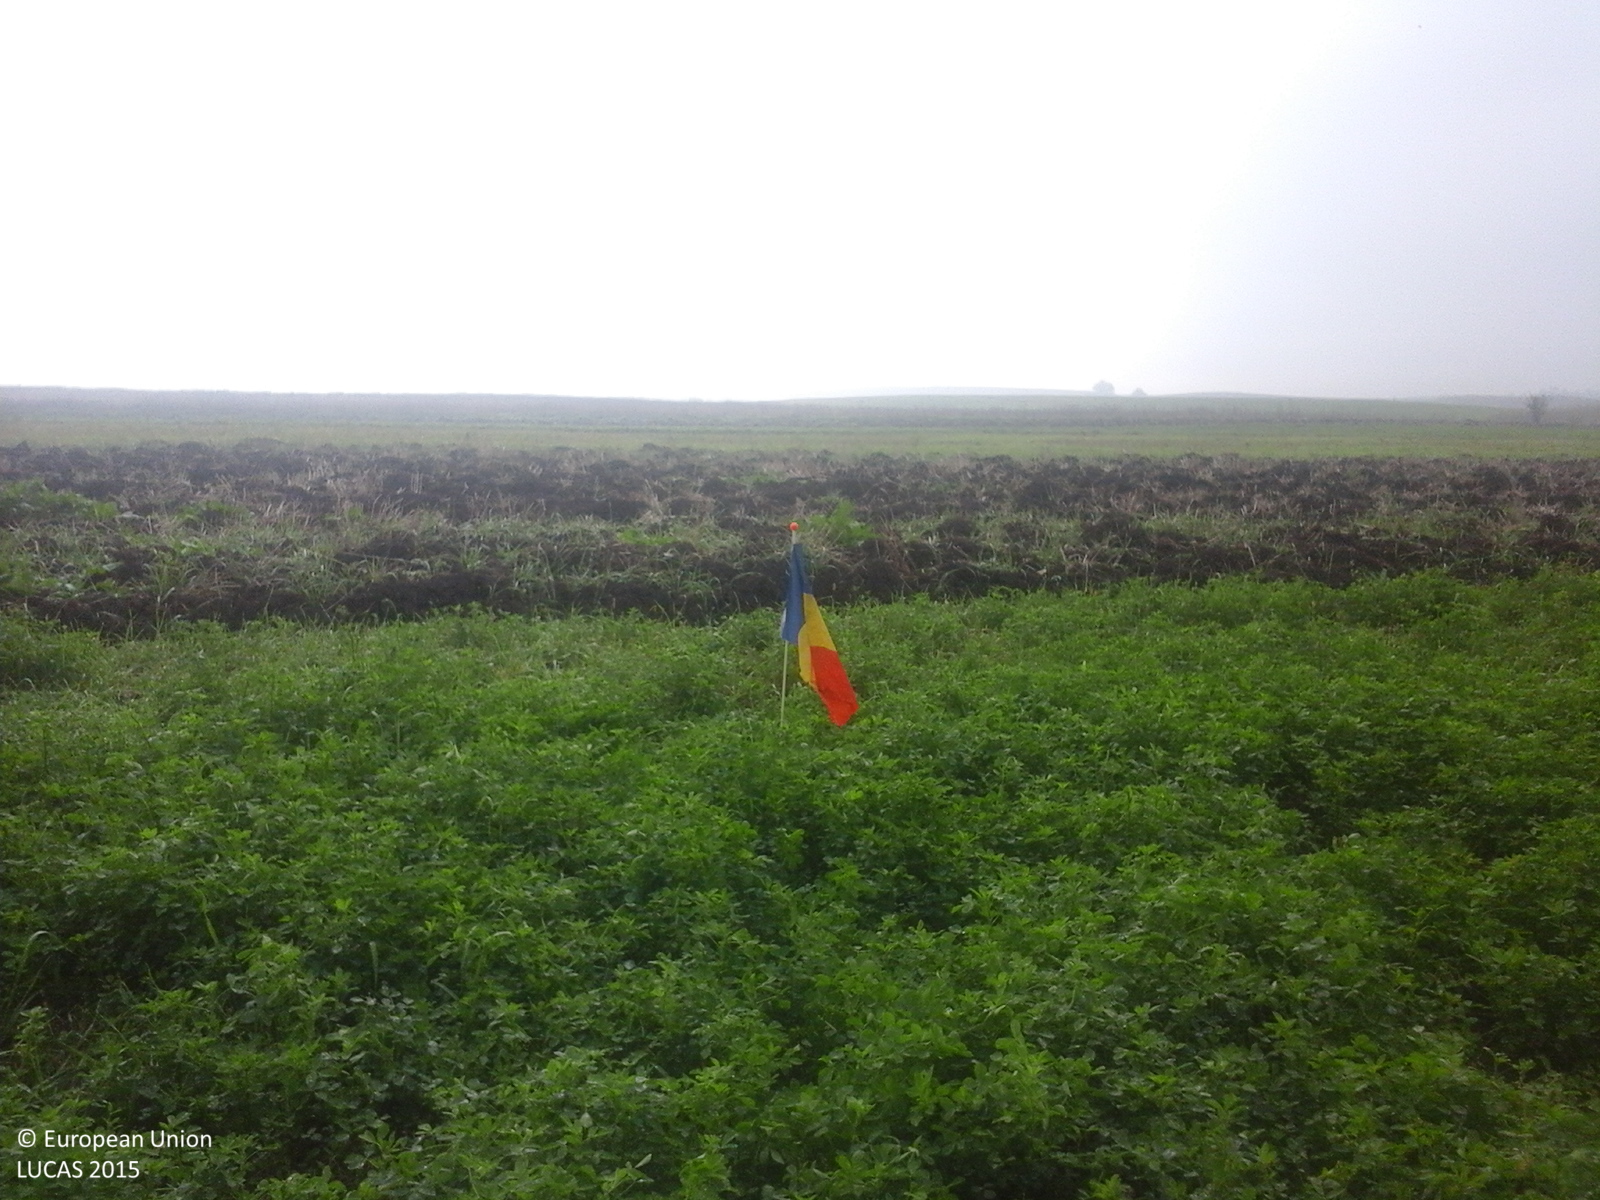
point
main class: Cropland
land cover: Lucerne
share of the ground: > 75 %
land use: Agriculture (excluding fallow land and kitchen gardens)
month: October
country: RO
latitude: 46.5279
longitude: 24.3595
